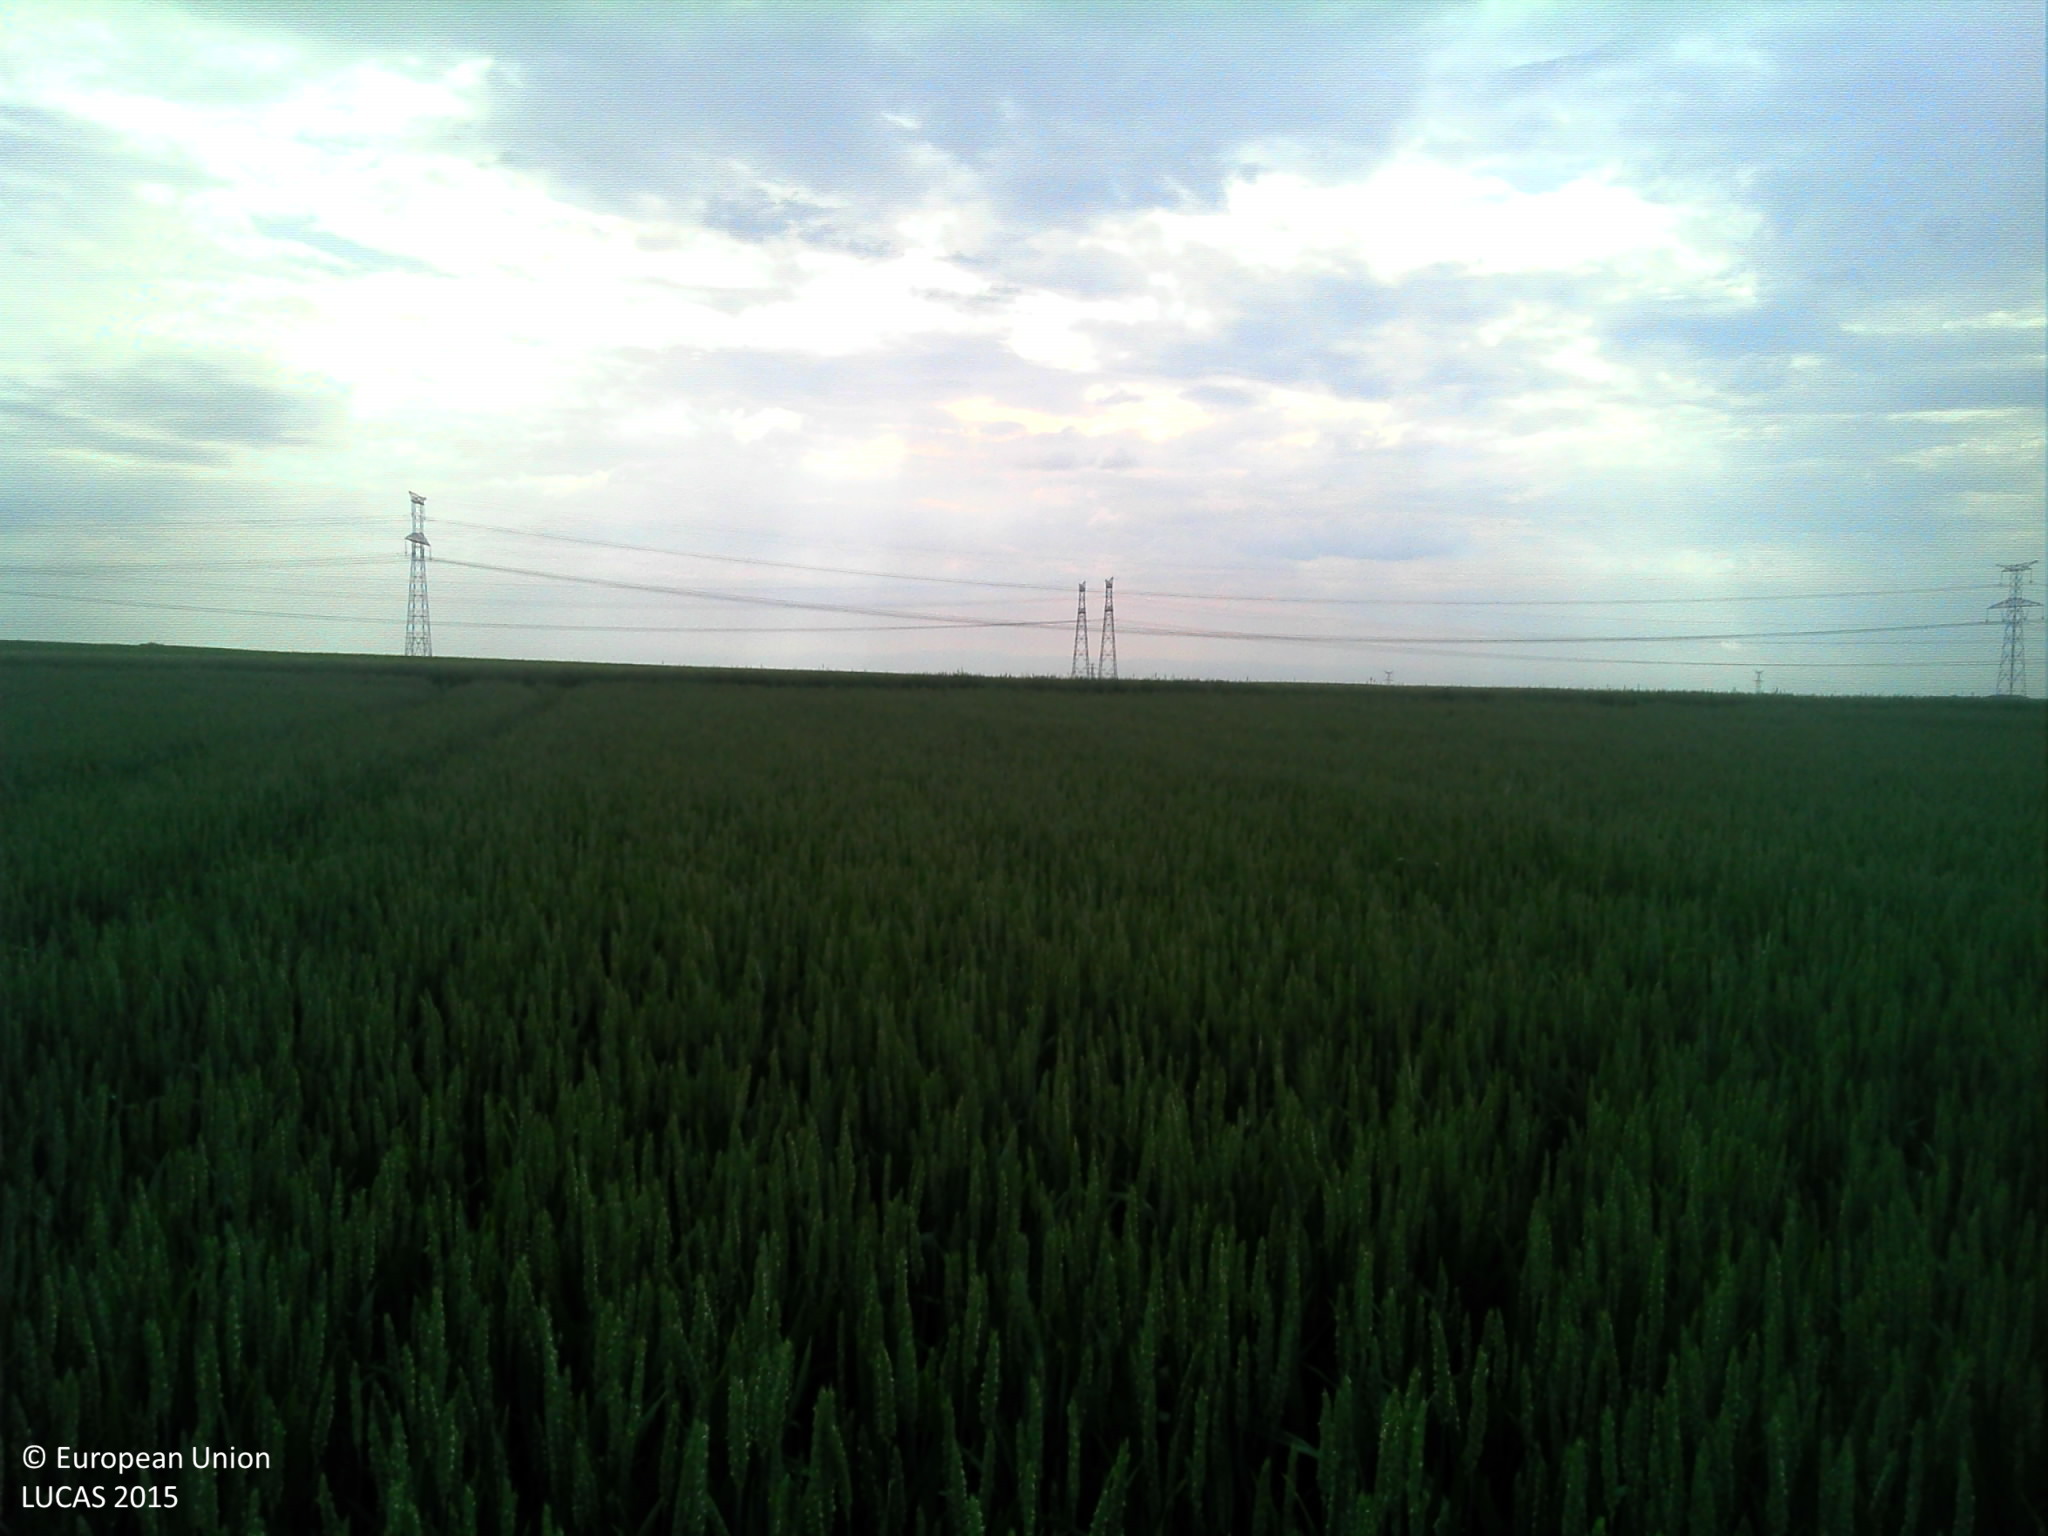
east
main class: Cropland
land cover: Common wheat
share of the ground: > 75 %
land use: Agriculture (excluding fallow land and kitchen gardens)
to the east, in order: Common wheat; Grass margins; Paved roads, cycling and walking lanes; Grass margins; Common wheat; Maize
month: May
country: FR
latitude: 48.6277
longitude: 7.5179
